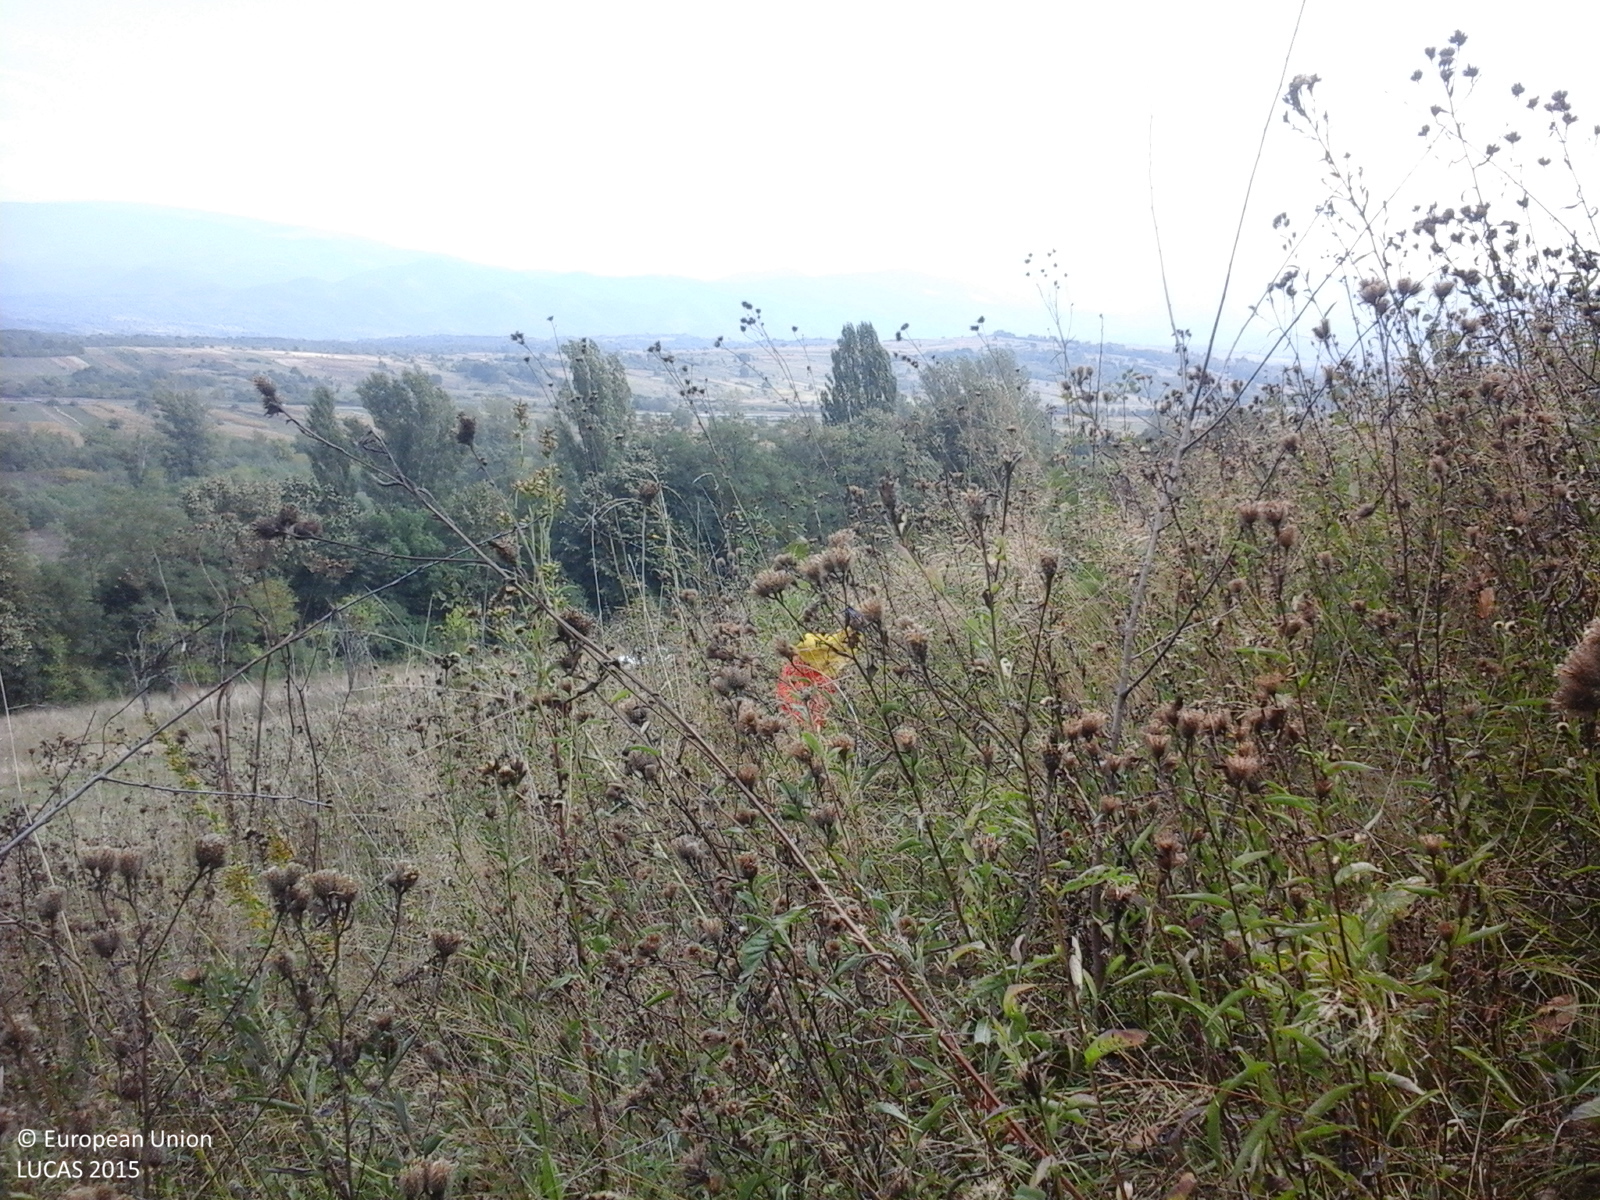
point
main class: Grassland
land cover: Grassland with sparse tree/shrub cover
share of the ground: > 75 %
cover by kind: herbaceous plants 85 %, shrubs 10 %, broadleaved forest trees 5 %
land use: Fallow land
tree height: < 5 m
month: September
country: RO
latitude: 45.3342
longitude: 22.2524
